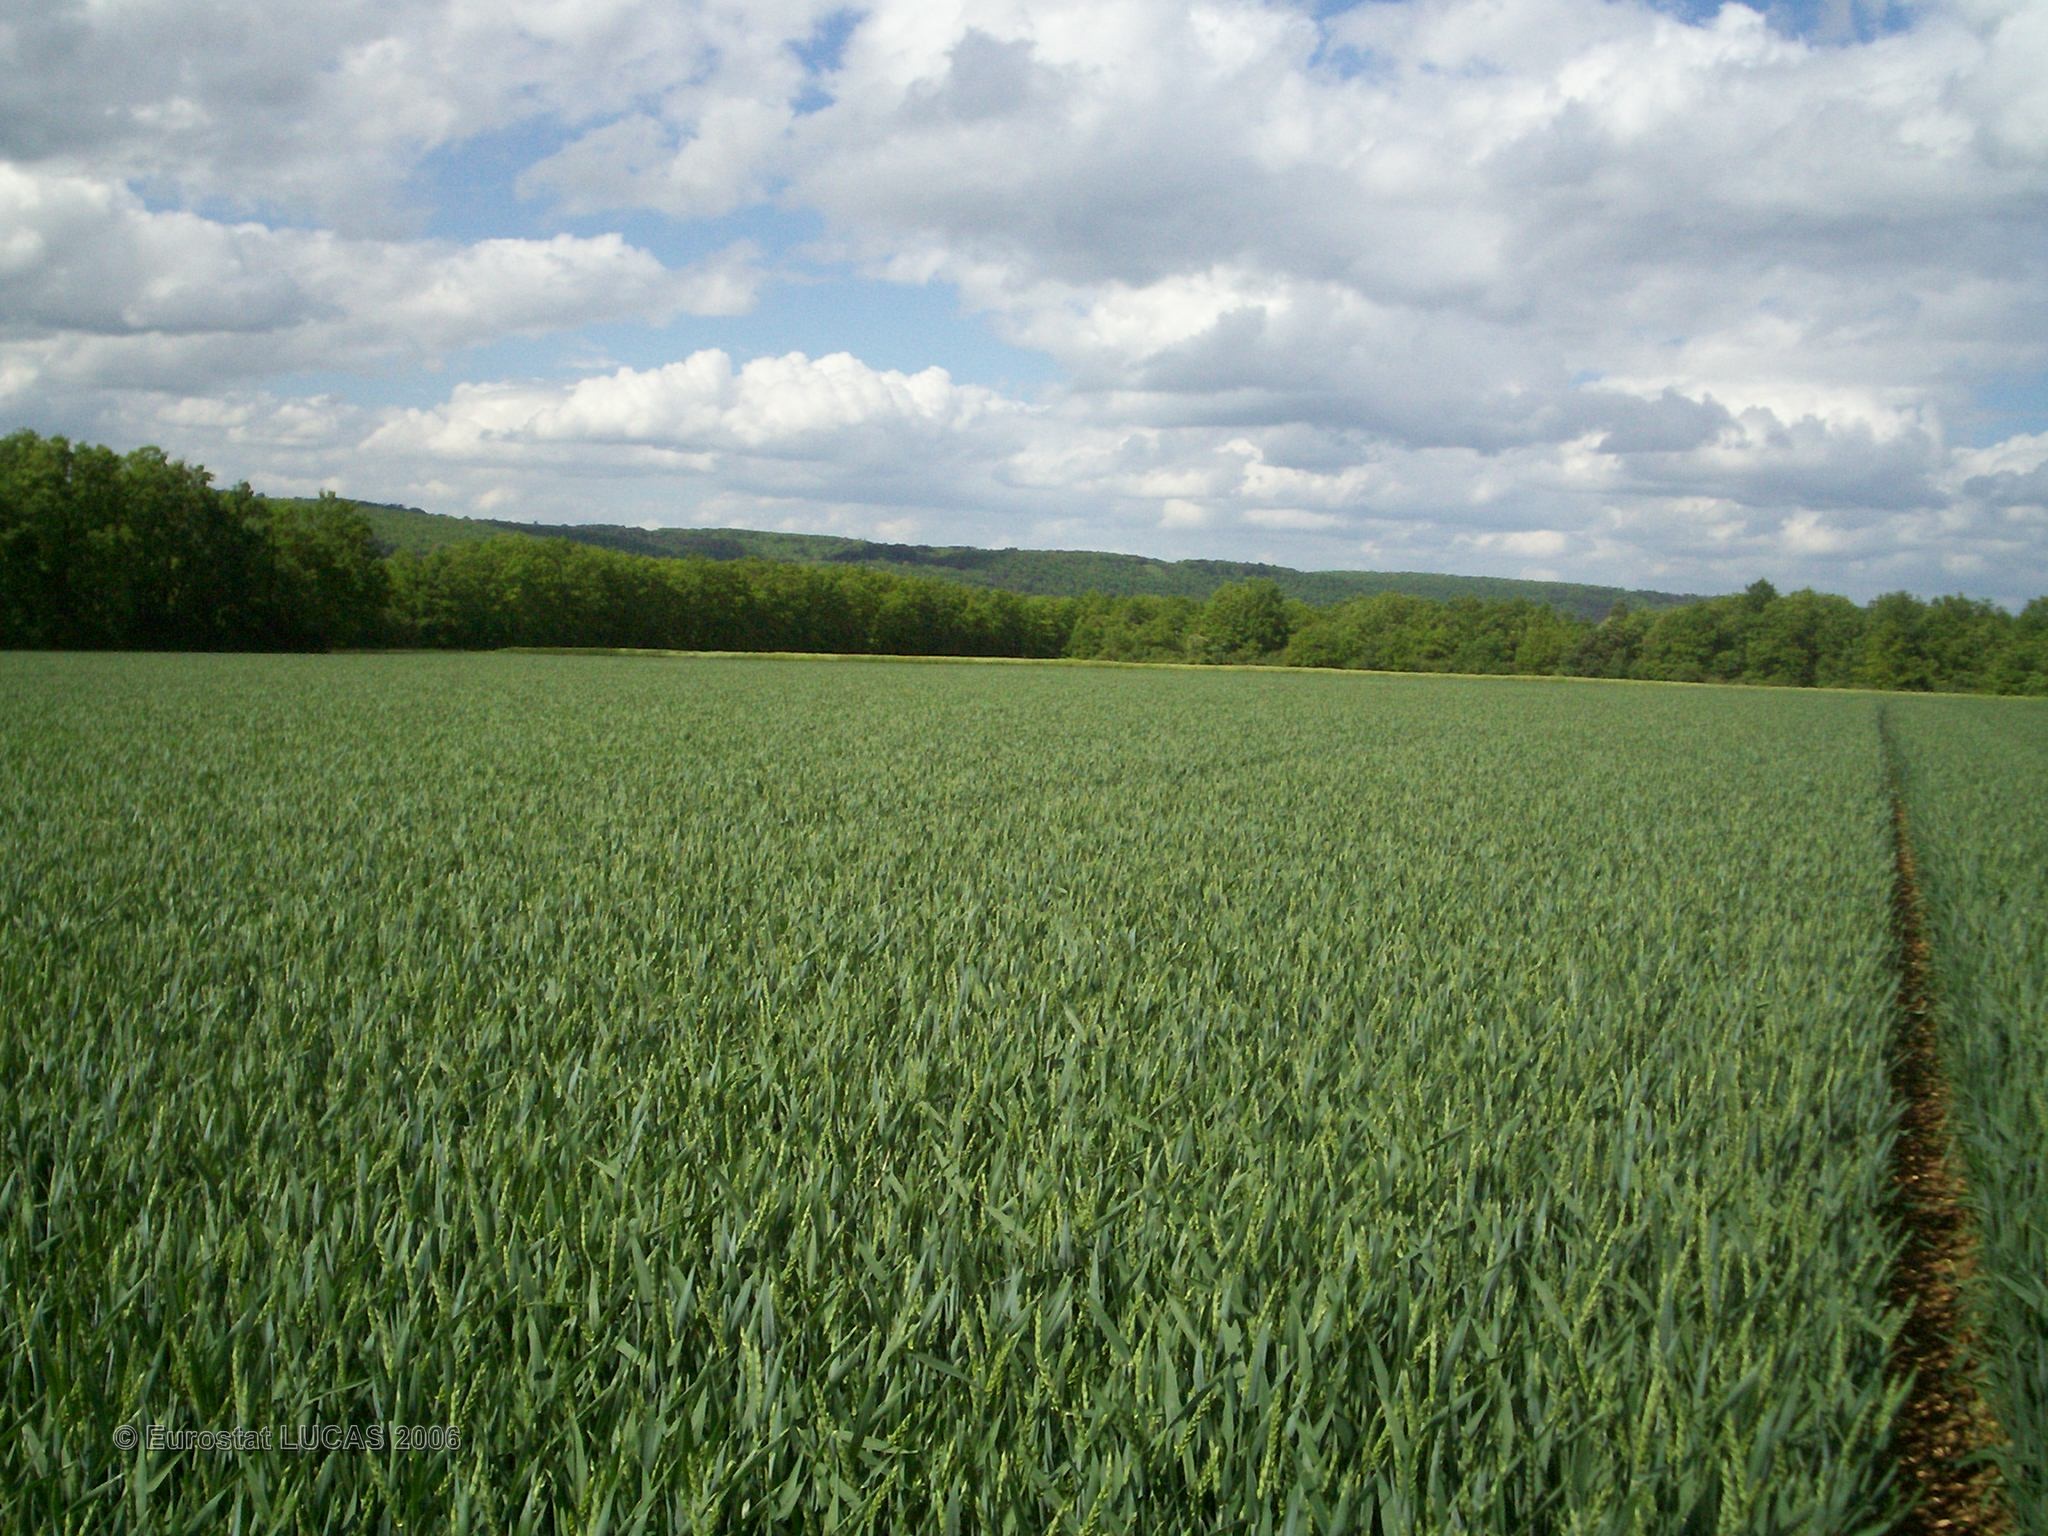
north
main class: Cropland
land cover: Common wheat
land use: Agriculture (excluding fallow land and kitchen gardens)
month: May
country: FR
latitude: 47.8464
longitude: 4.0506
